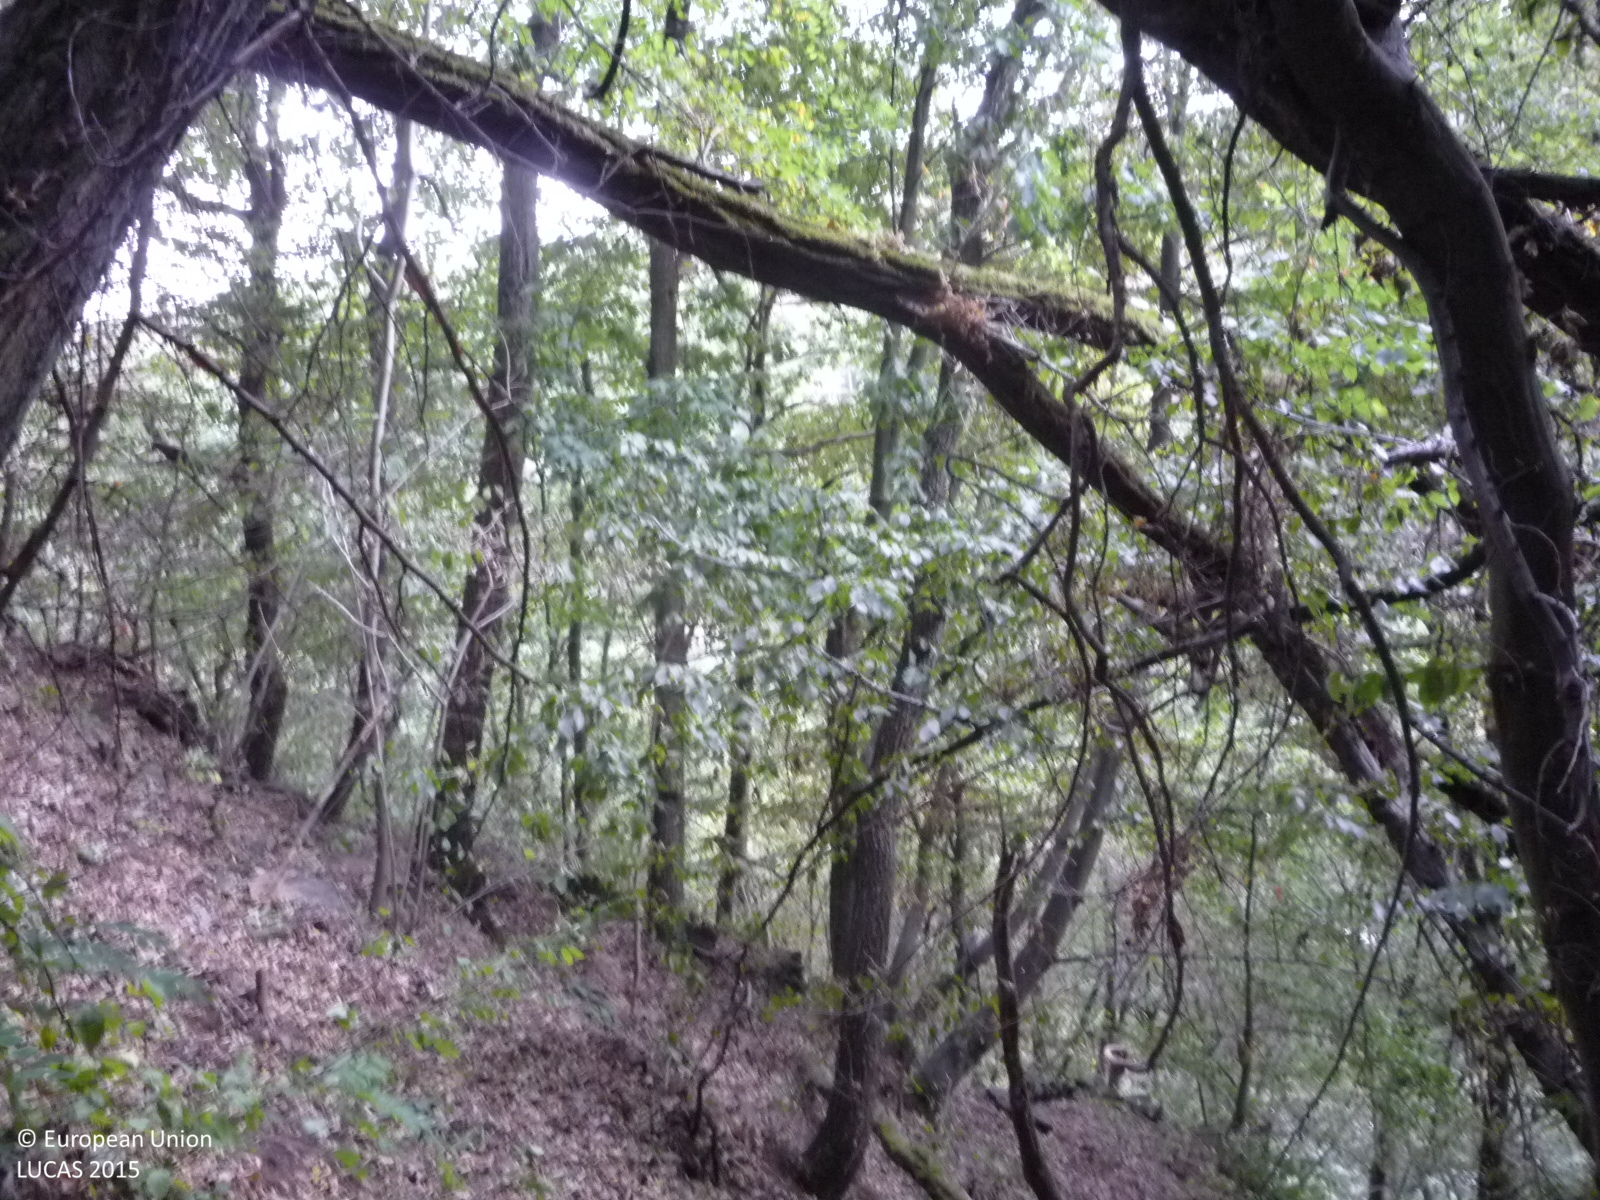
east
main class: Woodland
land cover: Broadleaved woodland
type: mesophytic deciduous forest
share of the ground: > 75 %
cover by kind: broadleaved forest trees 95 %, unconsolidated bare surface 5 %
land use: Forestry
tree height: > 5 m
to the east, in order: Broadleaved woodland; Artificial constructions in urban areas; Inland fresh running water; Artificial constructions in urban areas; Pine dominated coniferous woodland
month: August
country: CZ
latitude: 49.8626
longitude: 14.4671
